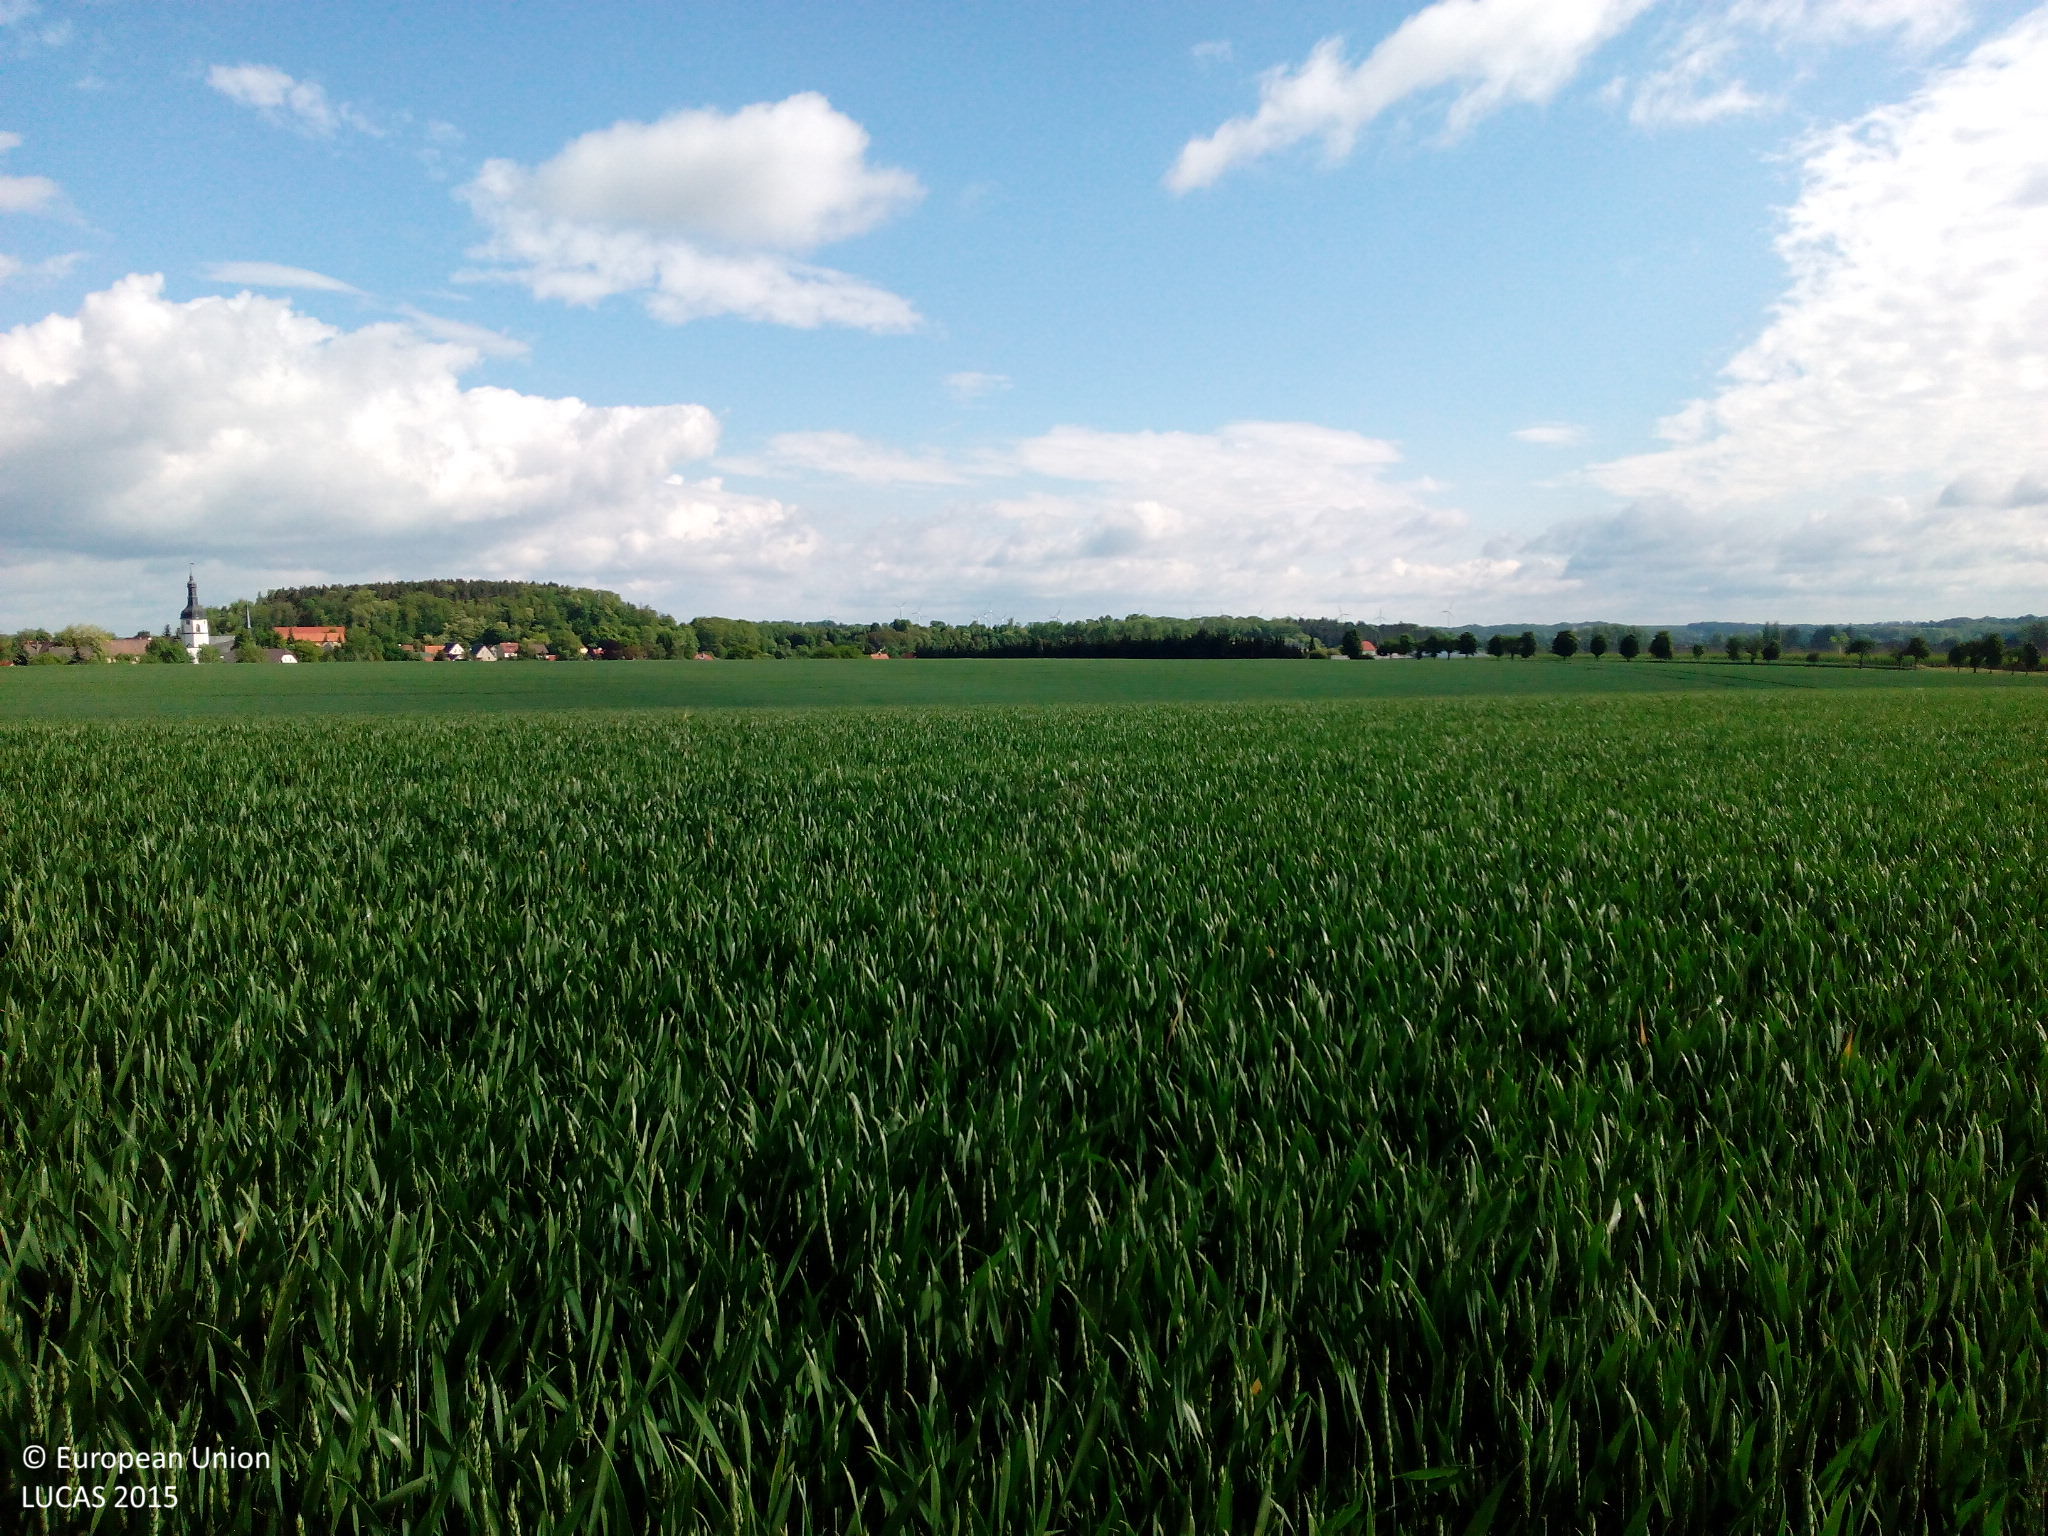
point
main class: Cropland
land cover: Common wheat
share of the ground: > 75 %
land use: Agriculture (excluding fallow land and kitchen gardens)
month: May
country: DE
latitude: 50.9875
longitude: 12.3503
